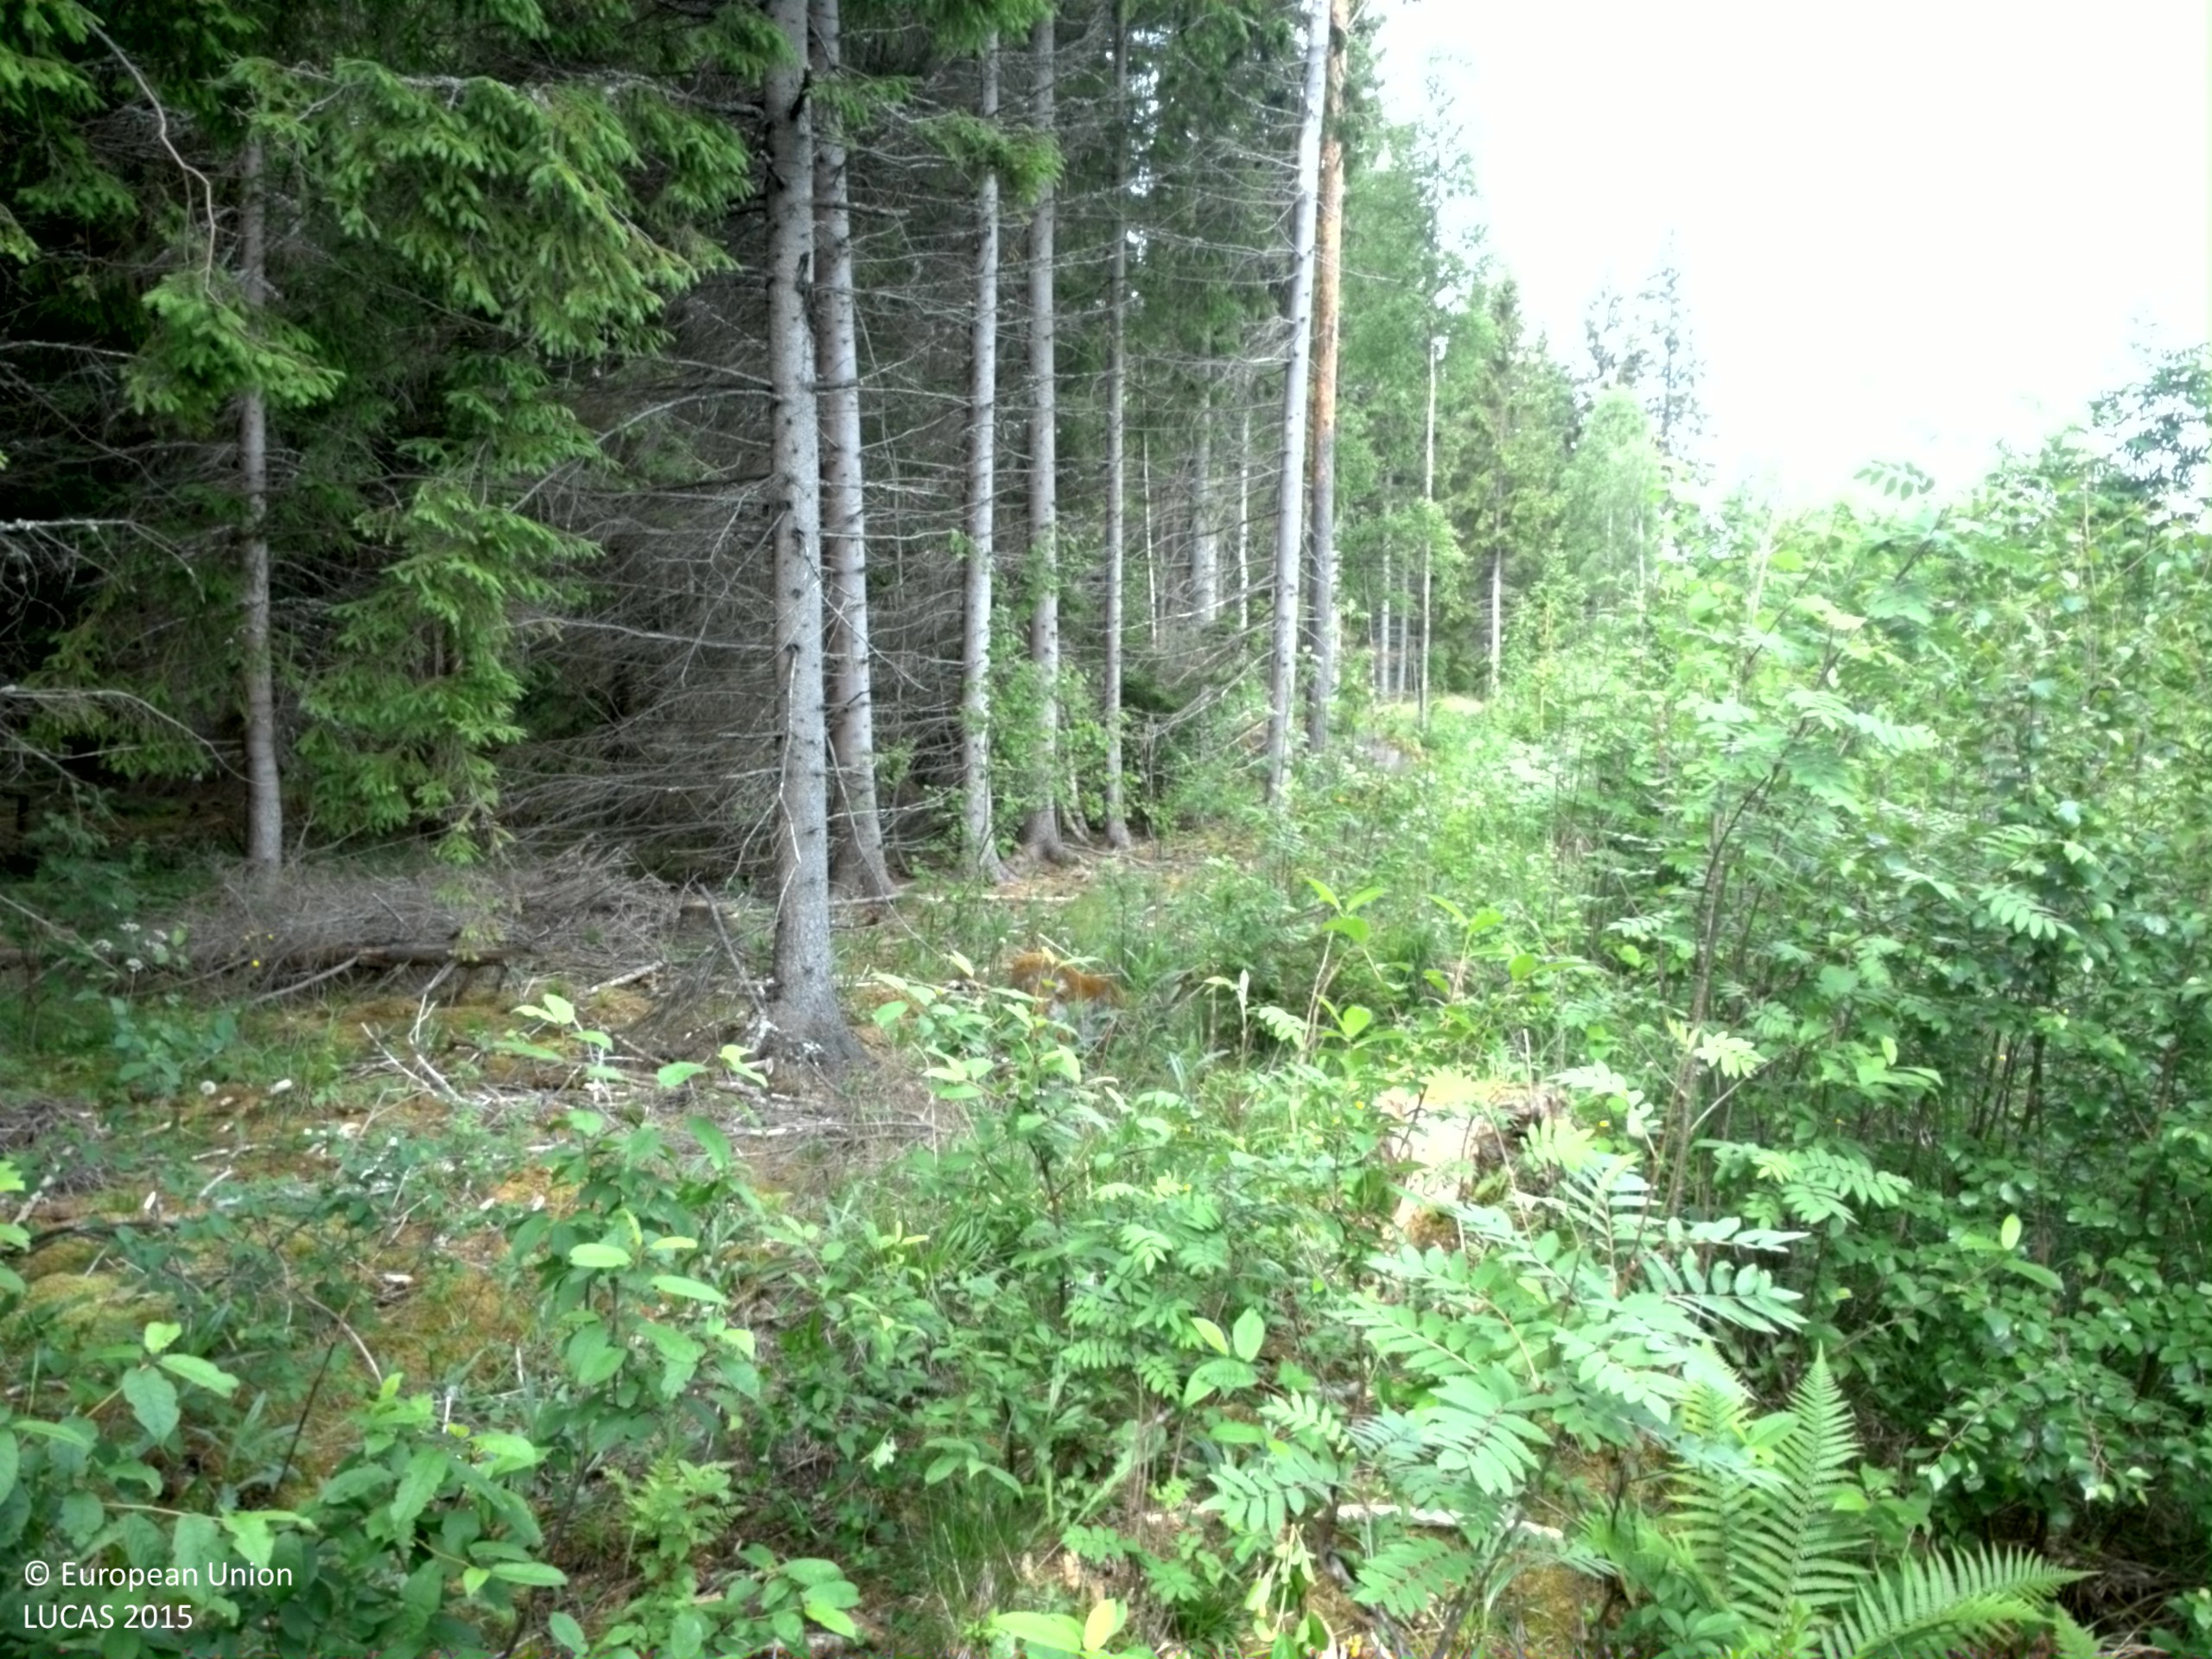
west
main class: Woodland
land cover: Broadleaved woodland
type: boreal forest
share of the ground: 25 - 50 %
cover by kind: herbaceous plants 55 %, broadleaved forest trees 35 %, coniferous forest trees 5 %, lichens and mosses 5 %
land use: Forestry
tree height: < 5 m
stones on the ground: < 10 %
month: June
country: SE
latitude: 60.2374
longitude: 17.7769
